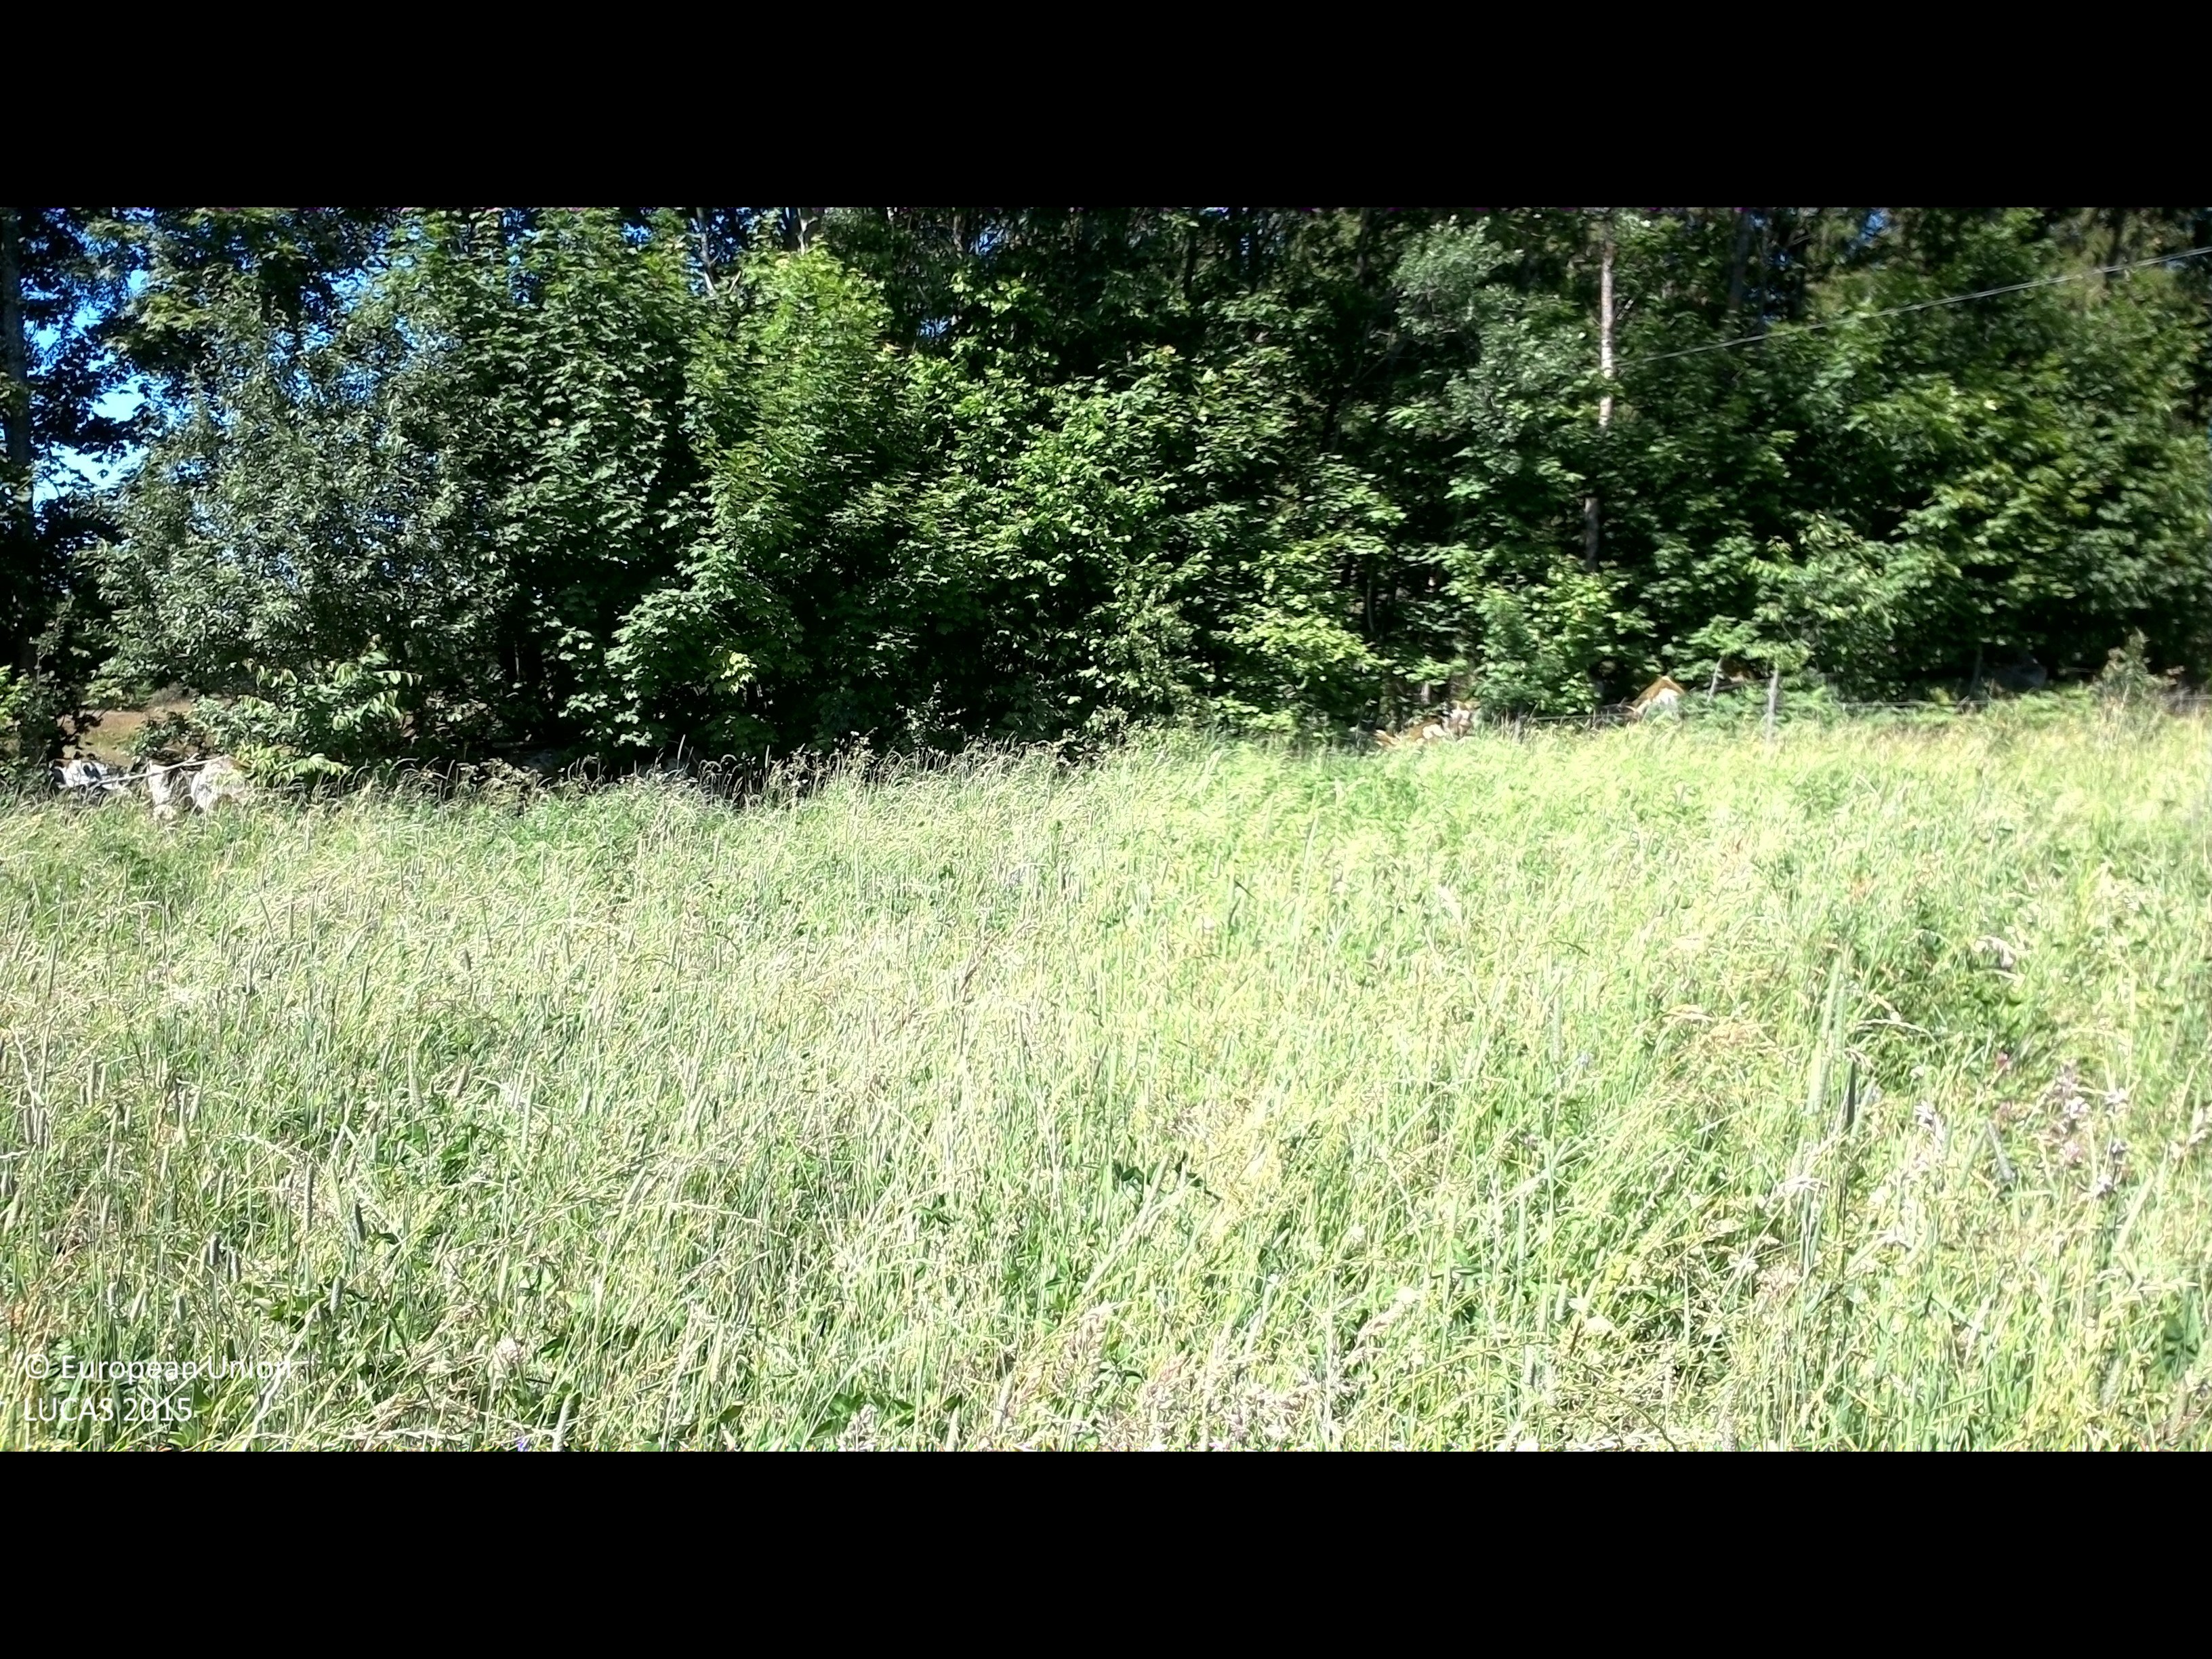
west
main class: Grassland
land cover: Grassland without tree/shrub cover
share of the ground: > 75 %
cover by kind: herbaceous plants 100 %
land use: Agriculture (excluding fallow land and kitchen gardens)
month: July
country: SE
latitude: 56.5114
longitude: 14.8241
